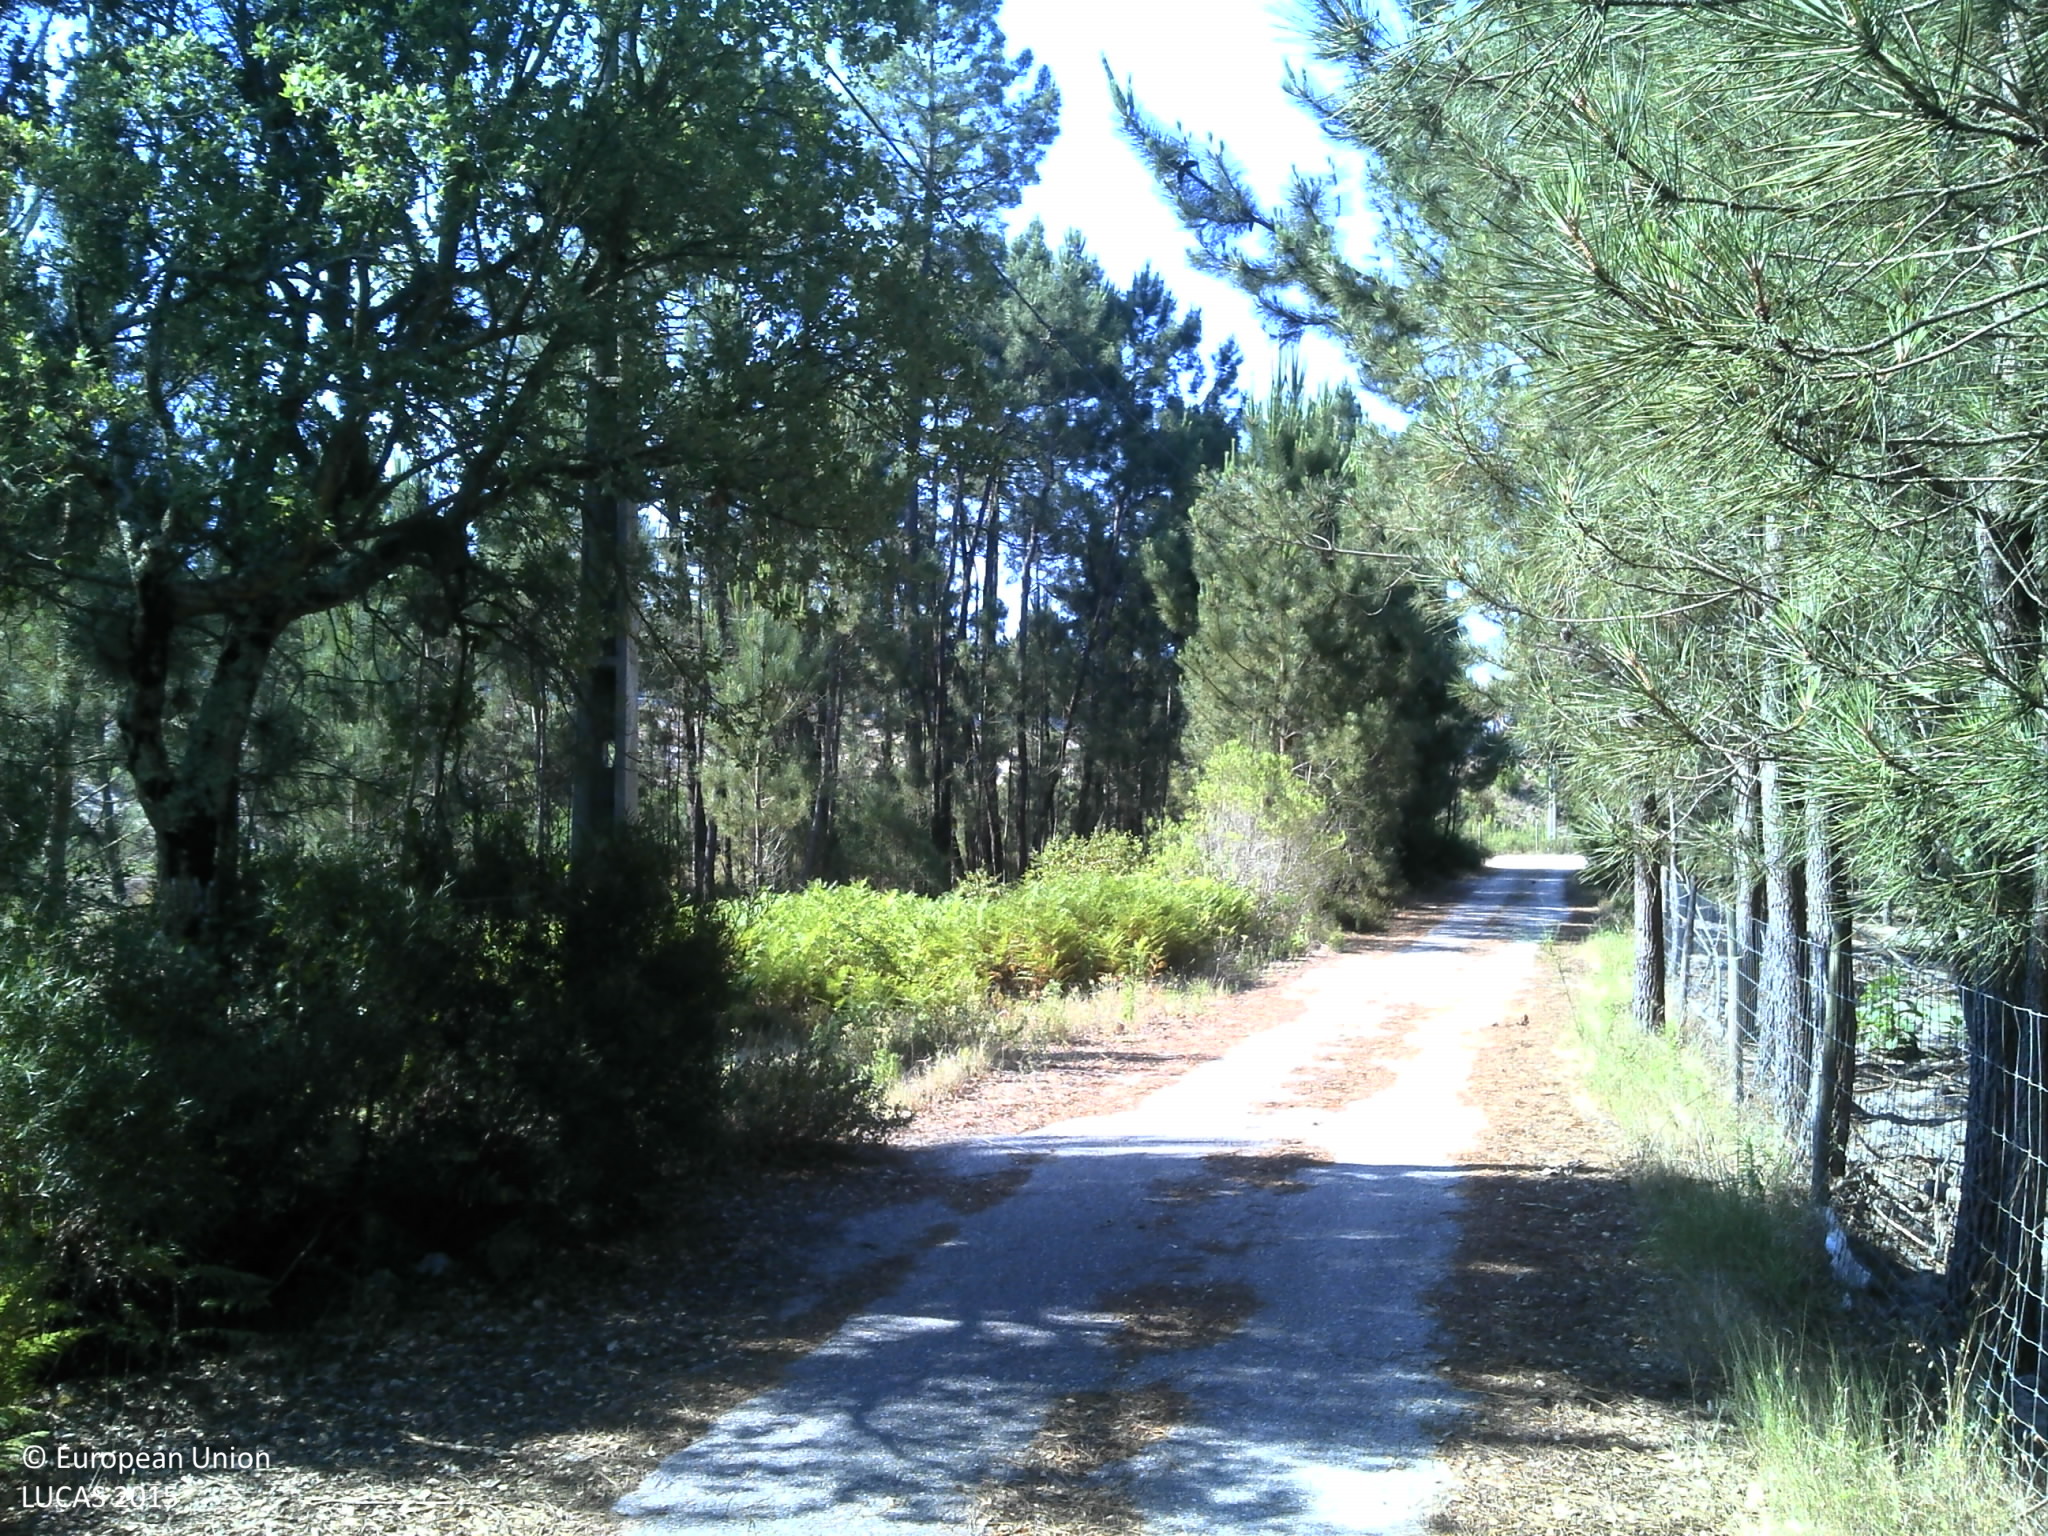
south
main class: Woodland
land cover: Pine dominated coniferous woodland
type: coniferous forest of the mediterranean region
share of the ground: 50 - 75 %
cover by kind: coniferous forest trees 60 %, unconsolidated bare surface 35 %, herbaceous plants 5 %
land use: Forestry
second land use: Agriculture (excluding fallow land and kitchen gardens)
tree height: > 5 m
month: June
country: PT
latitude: 40.3556
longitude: -8.7098
